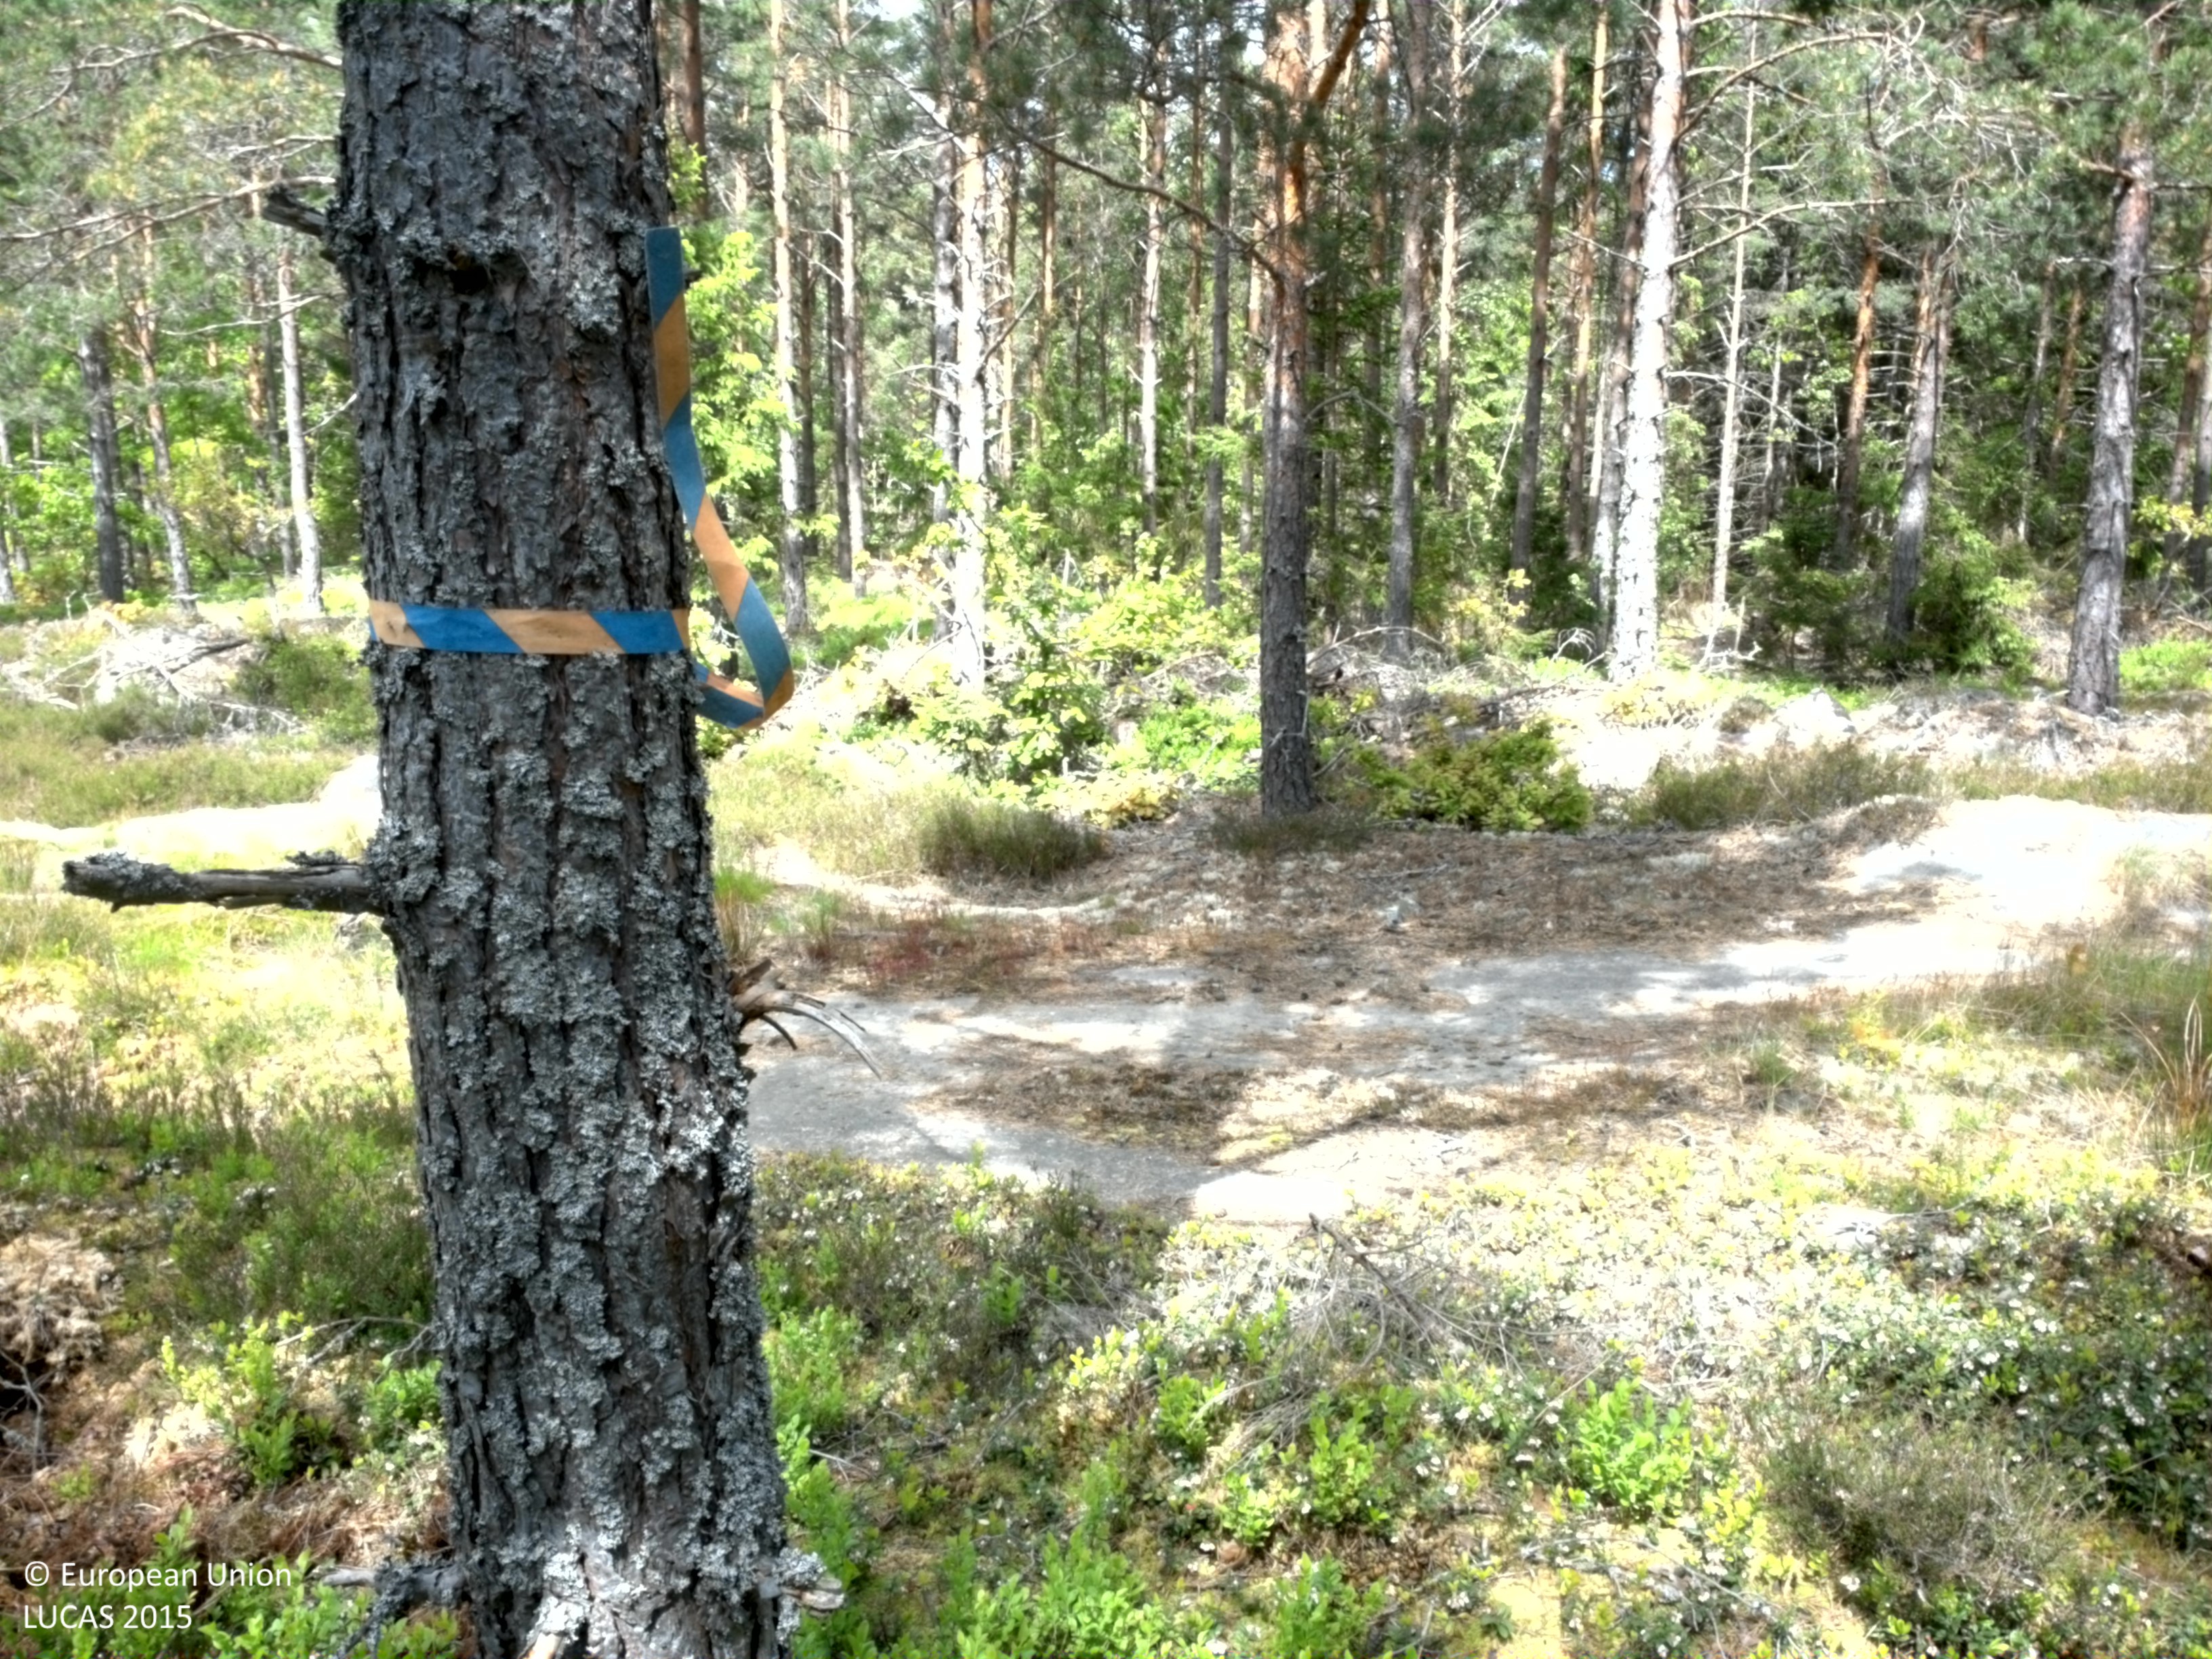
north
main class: Woodland
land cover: Pine dominated coniferous woodland
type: boreal forest
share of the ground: 50 - 75 %
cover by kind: coniferous forest trees 50 %, shrubs 25 %, lichens and mosses 25 %
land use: Forestry
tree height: > 5 m
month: May
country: SE
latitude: 57.1631
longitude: 16.4321
